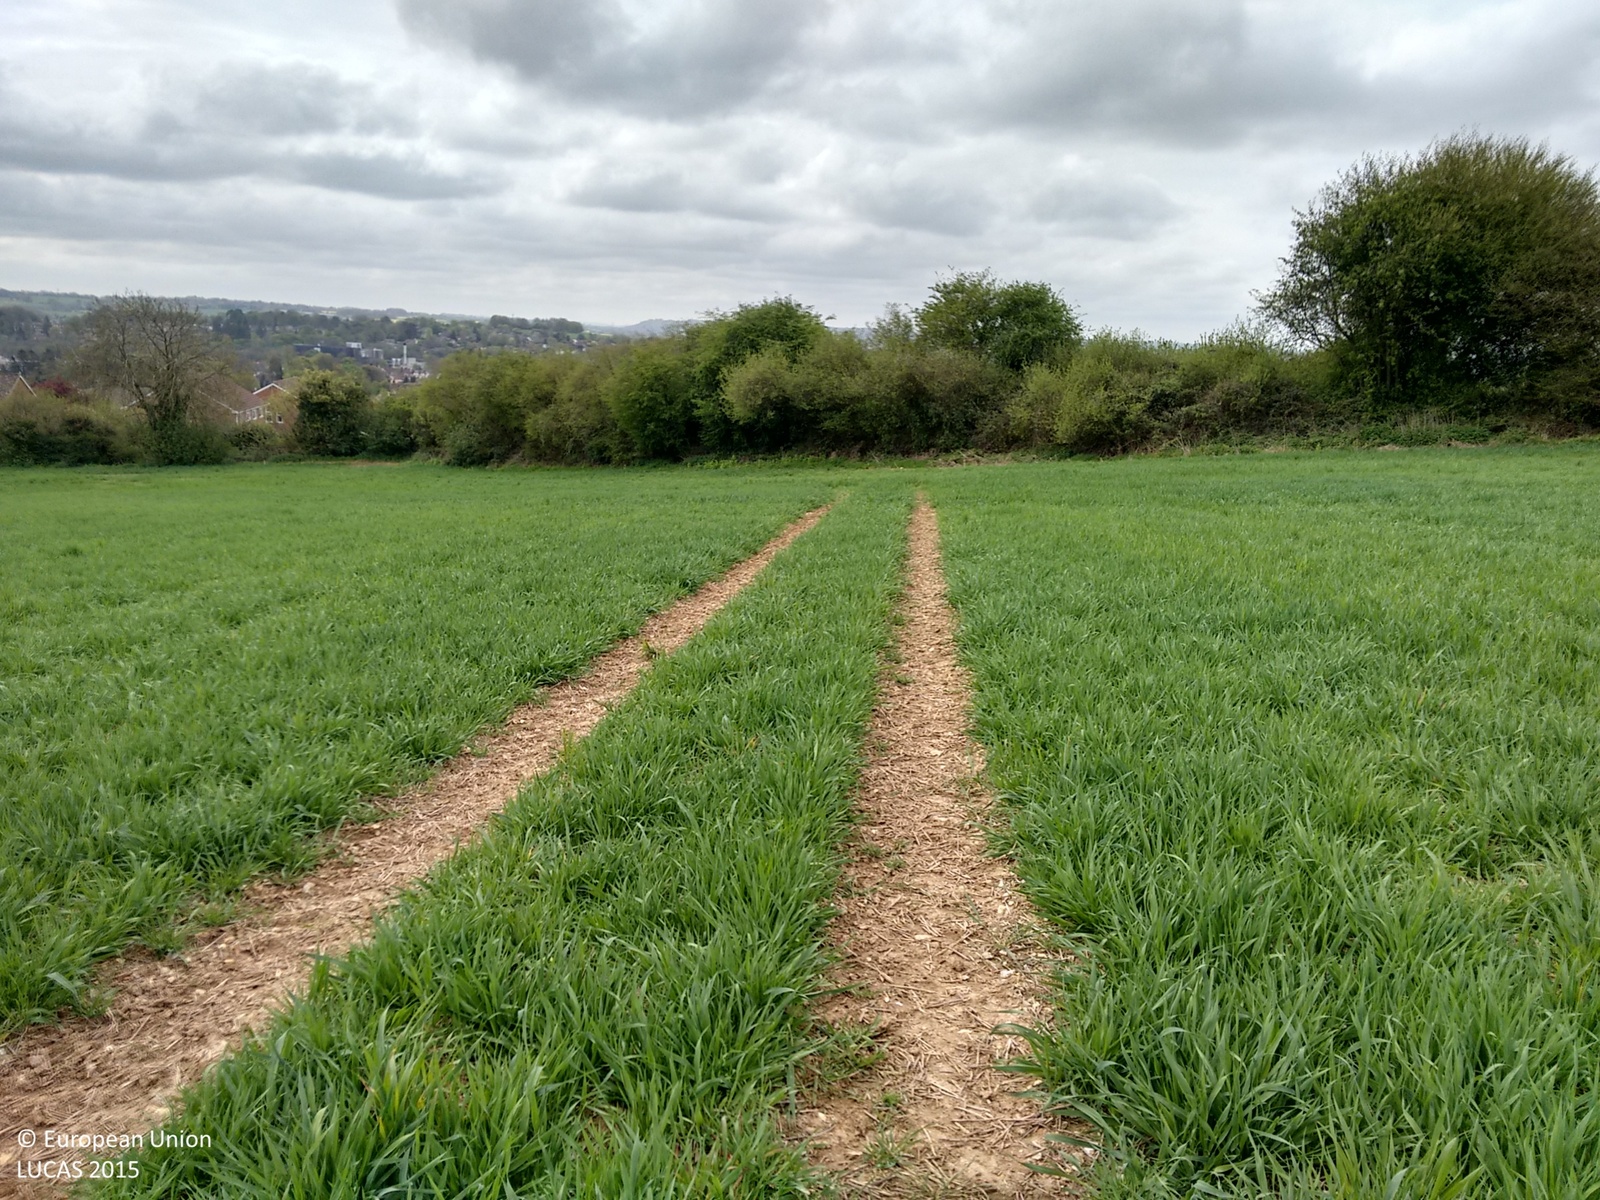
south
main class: Cropland
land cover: Oats
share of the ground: 50 - 75 %
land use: Agriculture (excluding fallow land and kitchen gardens)
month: May
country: GB
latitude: 51.1584
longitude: -0.9826
